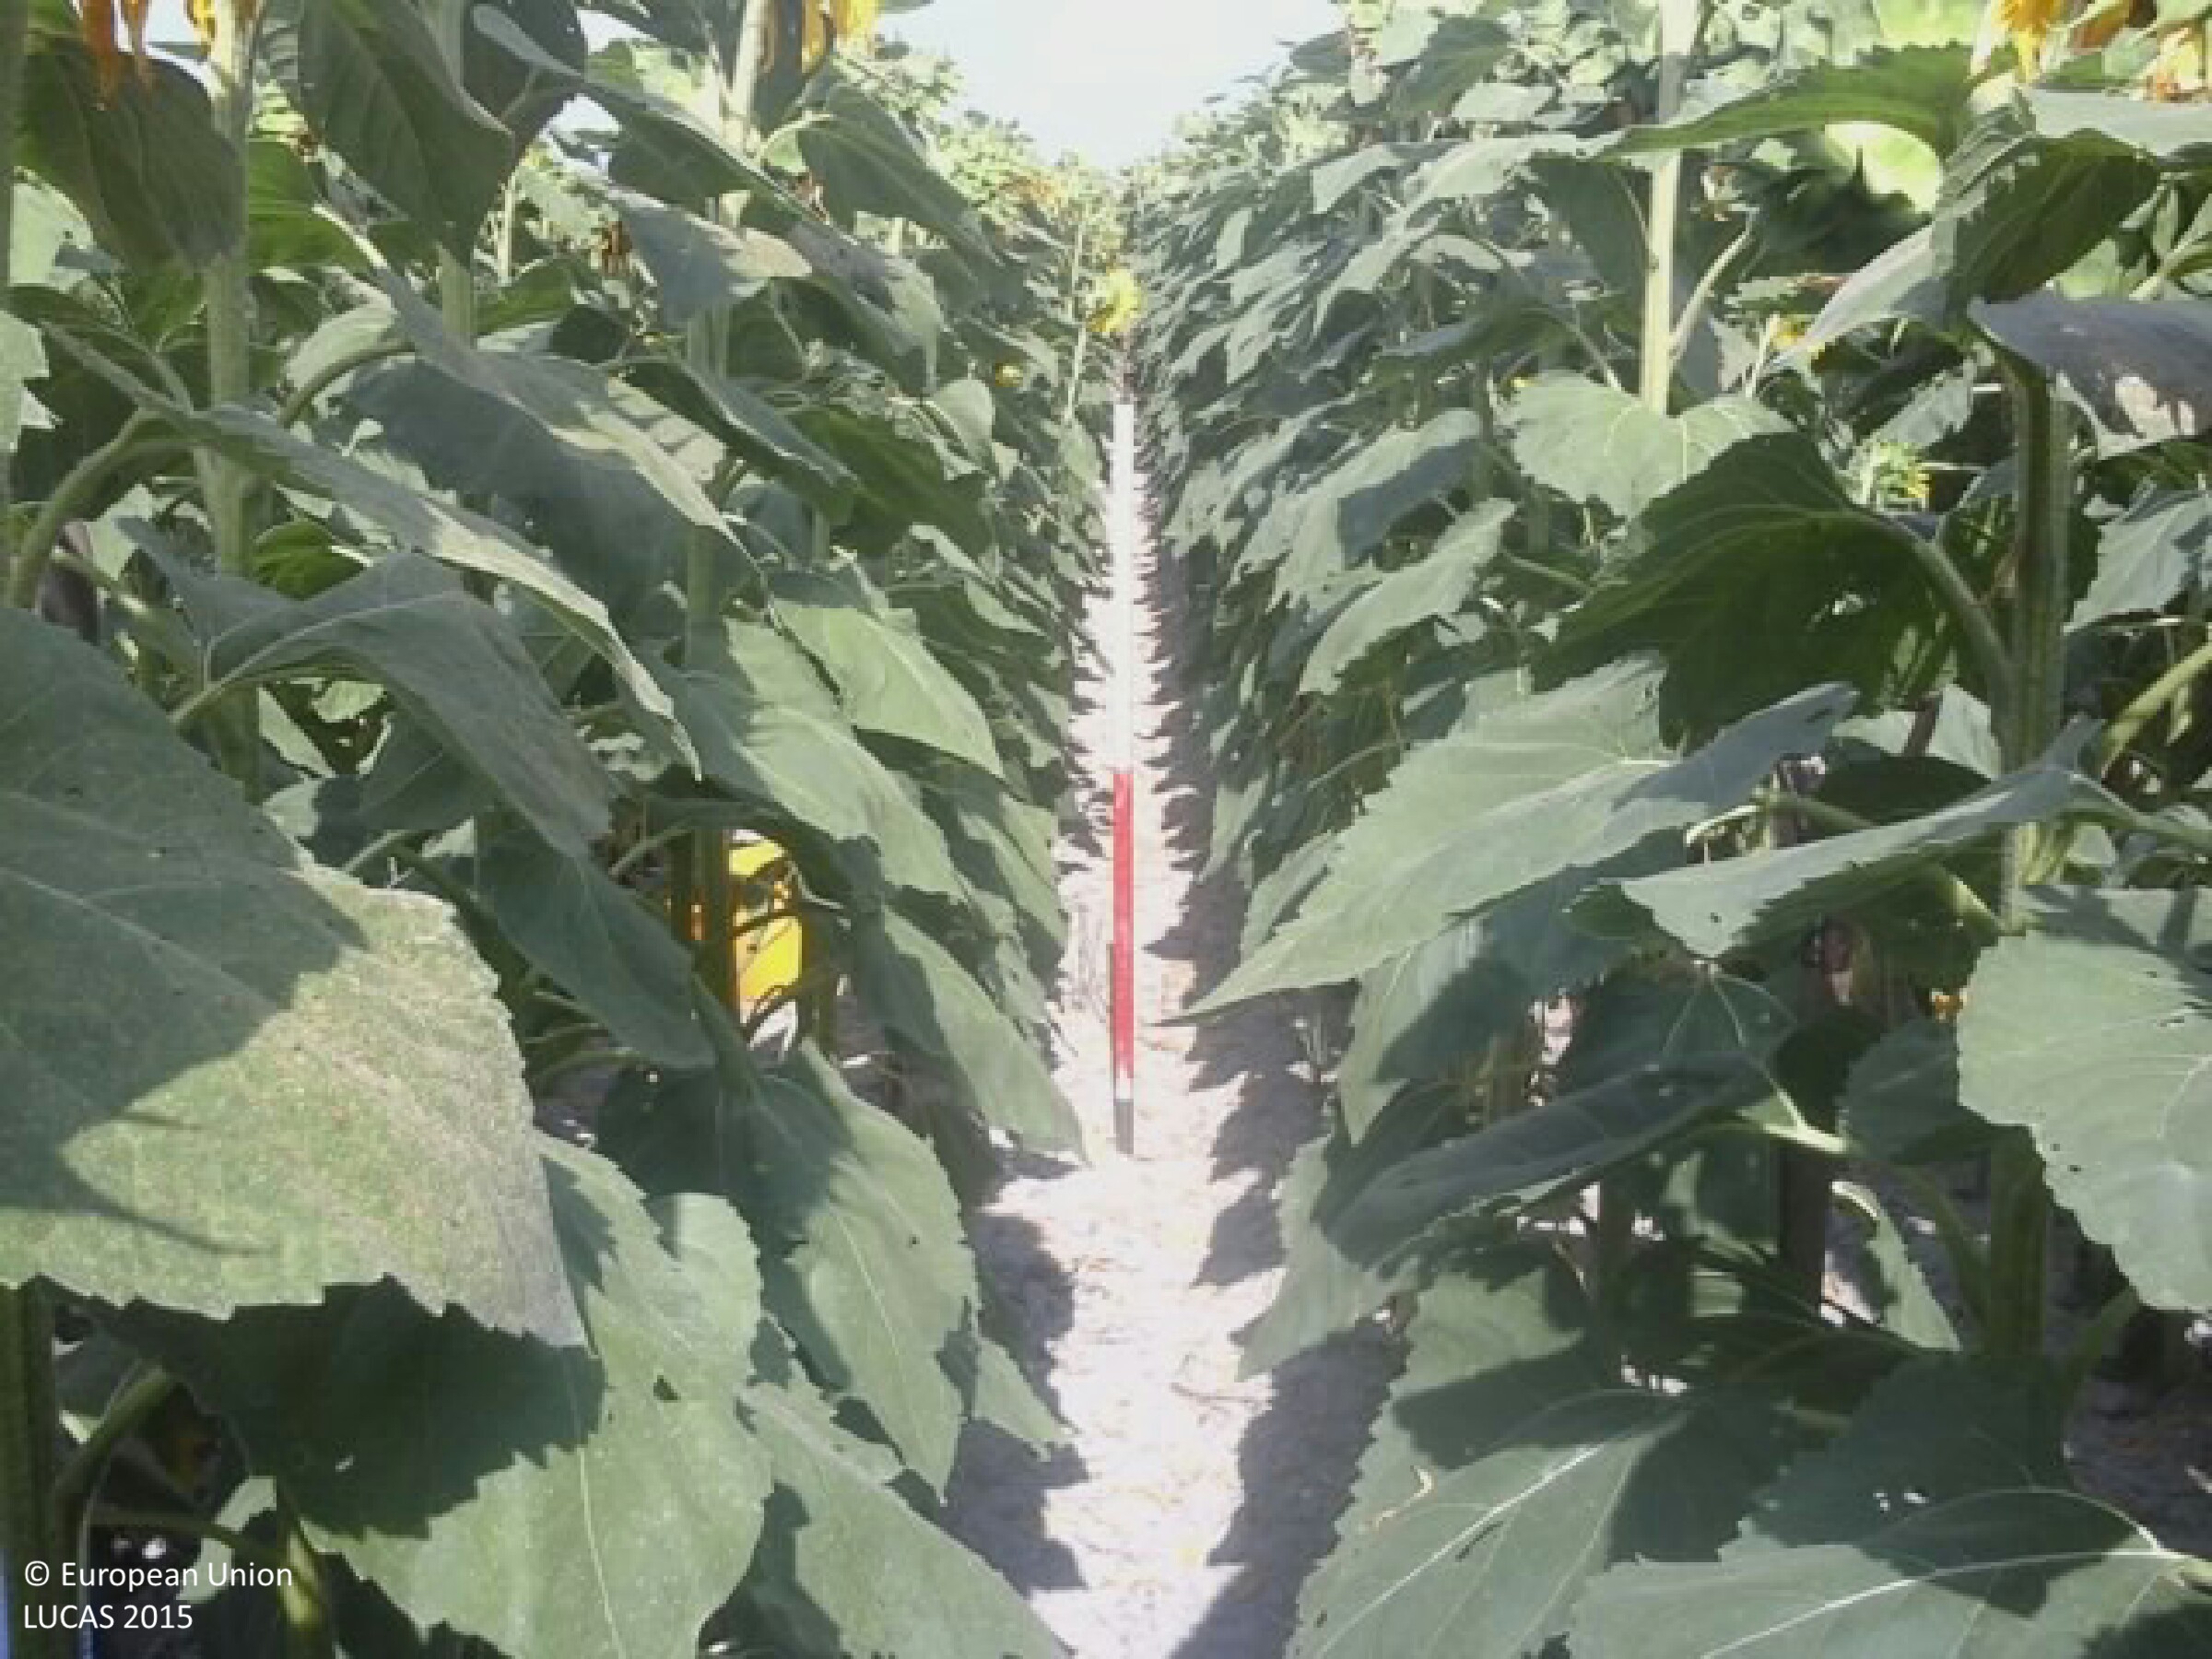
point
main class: Cropland
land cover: Sunflower
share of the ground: > 75 %
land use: Agriculture (excluding fallow land and kitchen gardens)
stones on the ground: < 10 %
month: July
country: HU
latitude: 46.6667
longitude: 18.9145
